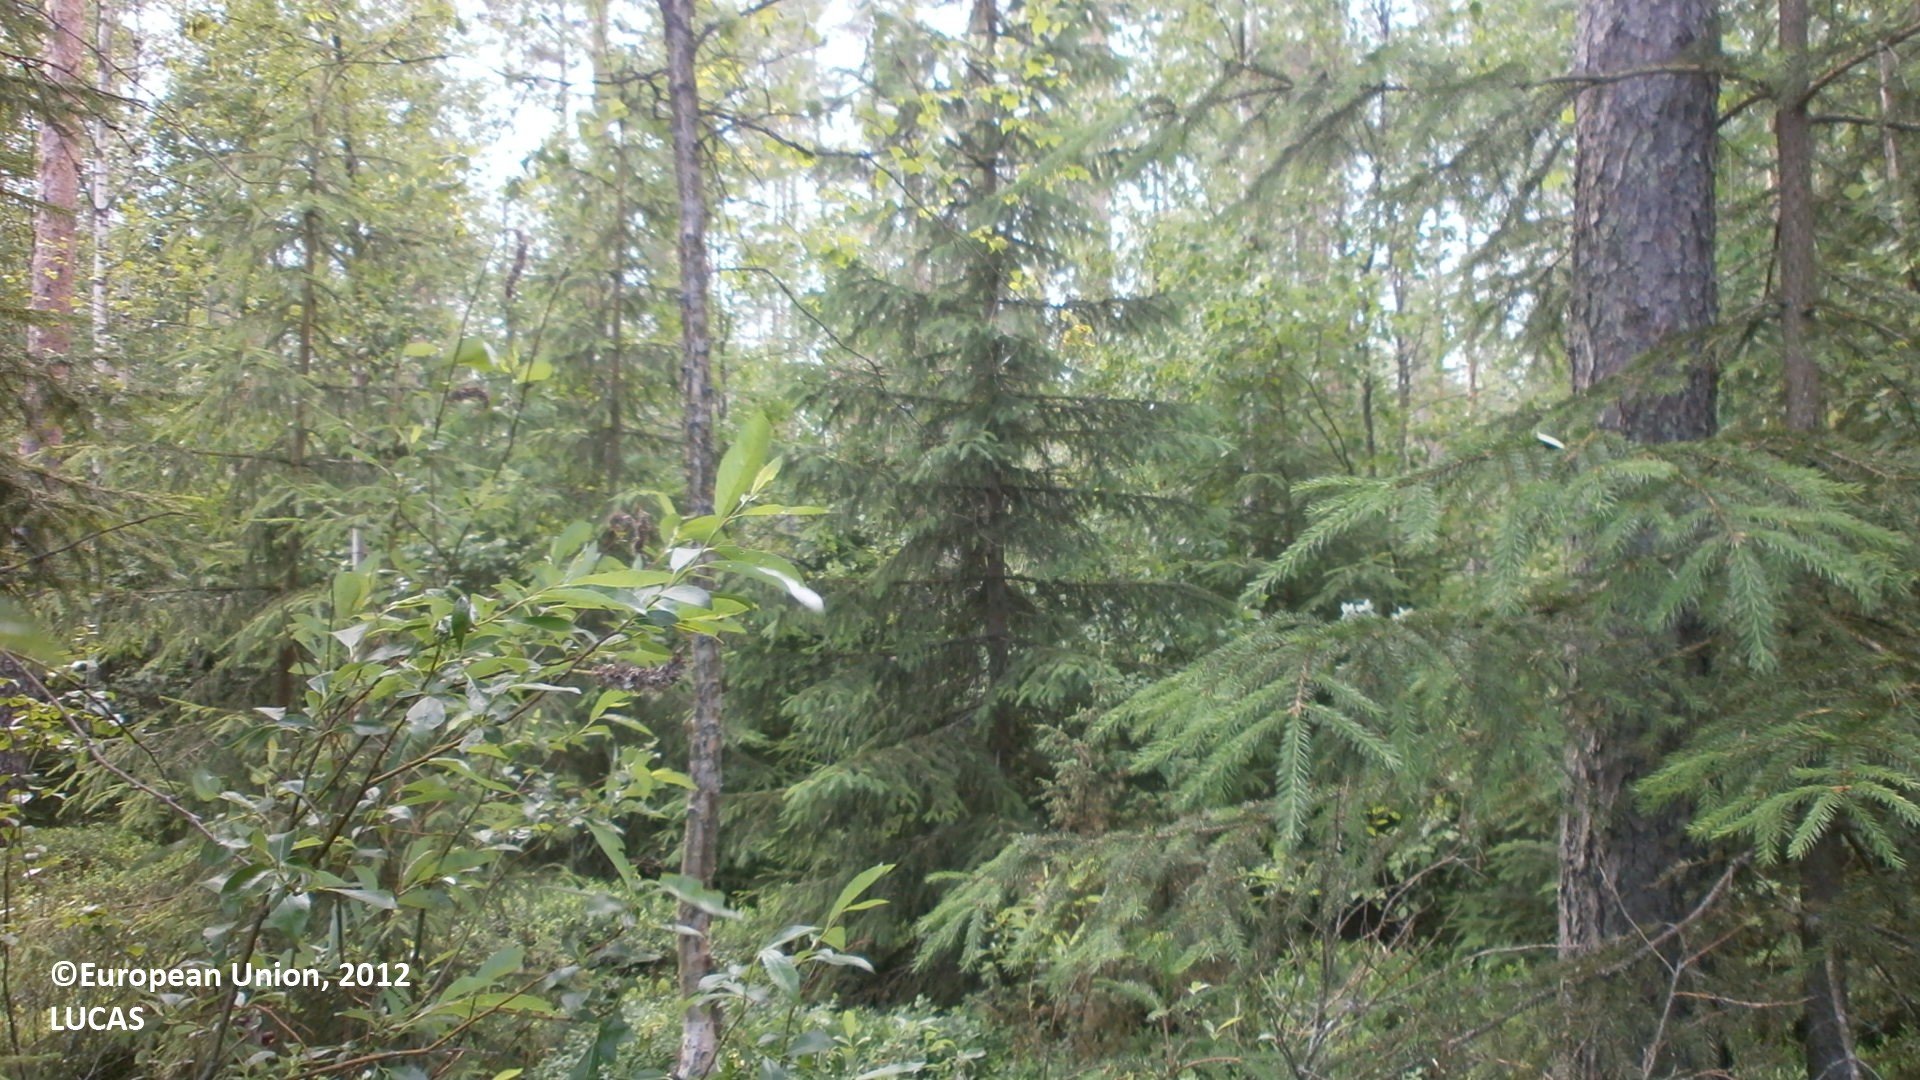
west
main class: Woodland
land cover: Pine dominated mixed woodland
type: boreal forest
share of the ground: > 75 %
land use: Forestry
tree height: > 5 m
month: July
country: FI
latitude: 63.9608
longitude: 24.7602
